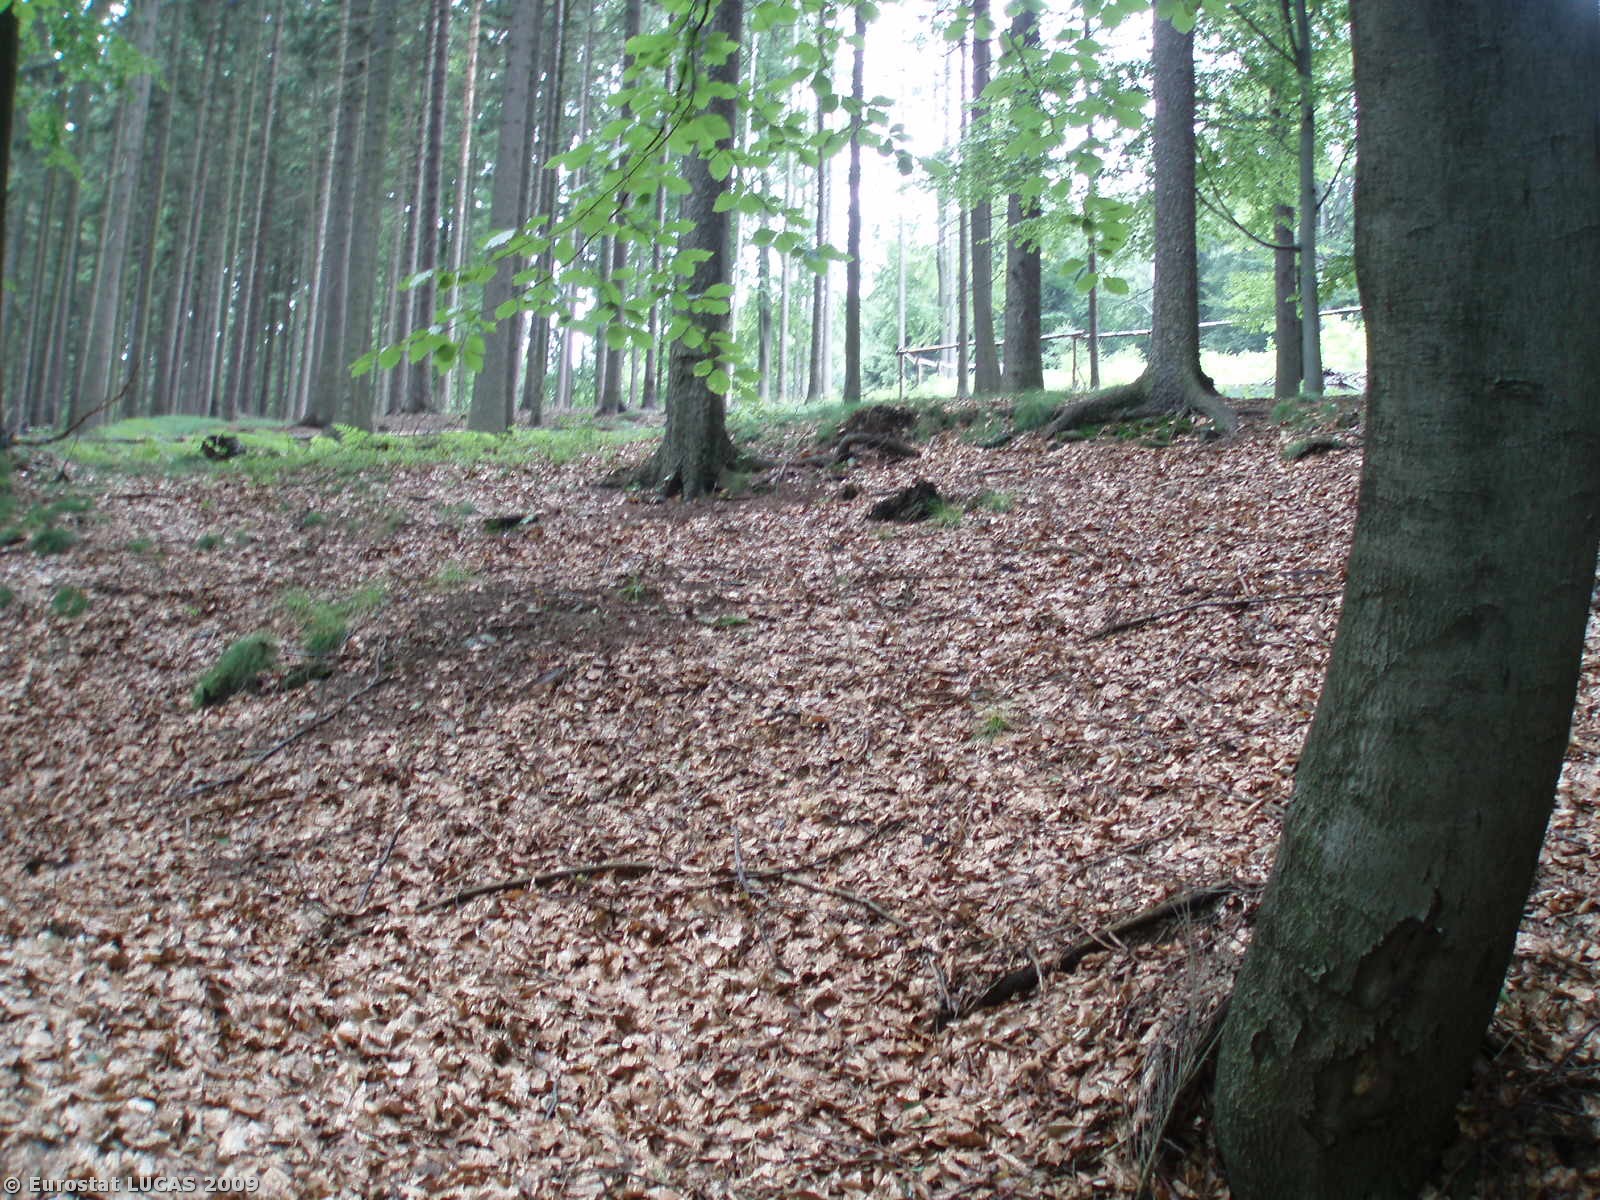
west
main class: Woodland
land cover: Broadleaved woodland
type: beech forest
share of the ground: > 75 %
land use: Forestry
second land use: Nature reserves
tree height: > 5 m
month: July
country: CZ
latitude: 50.8055
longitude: 14.7561
